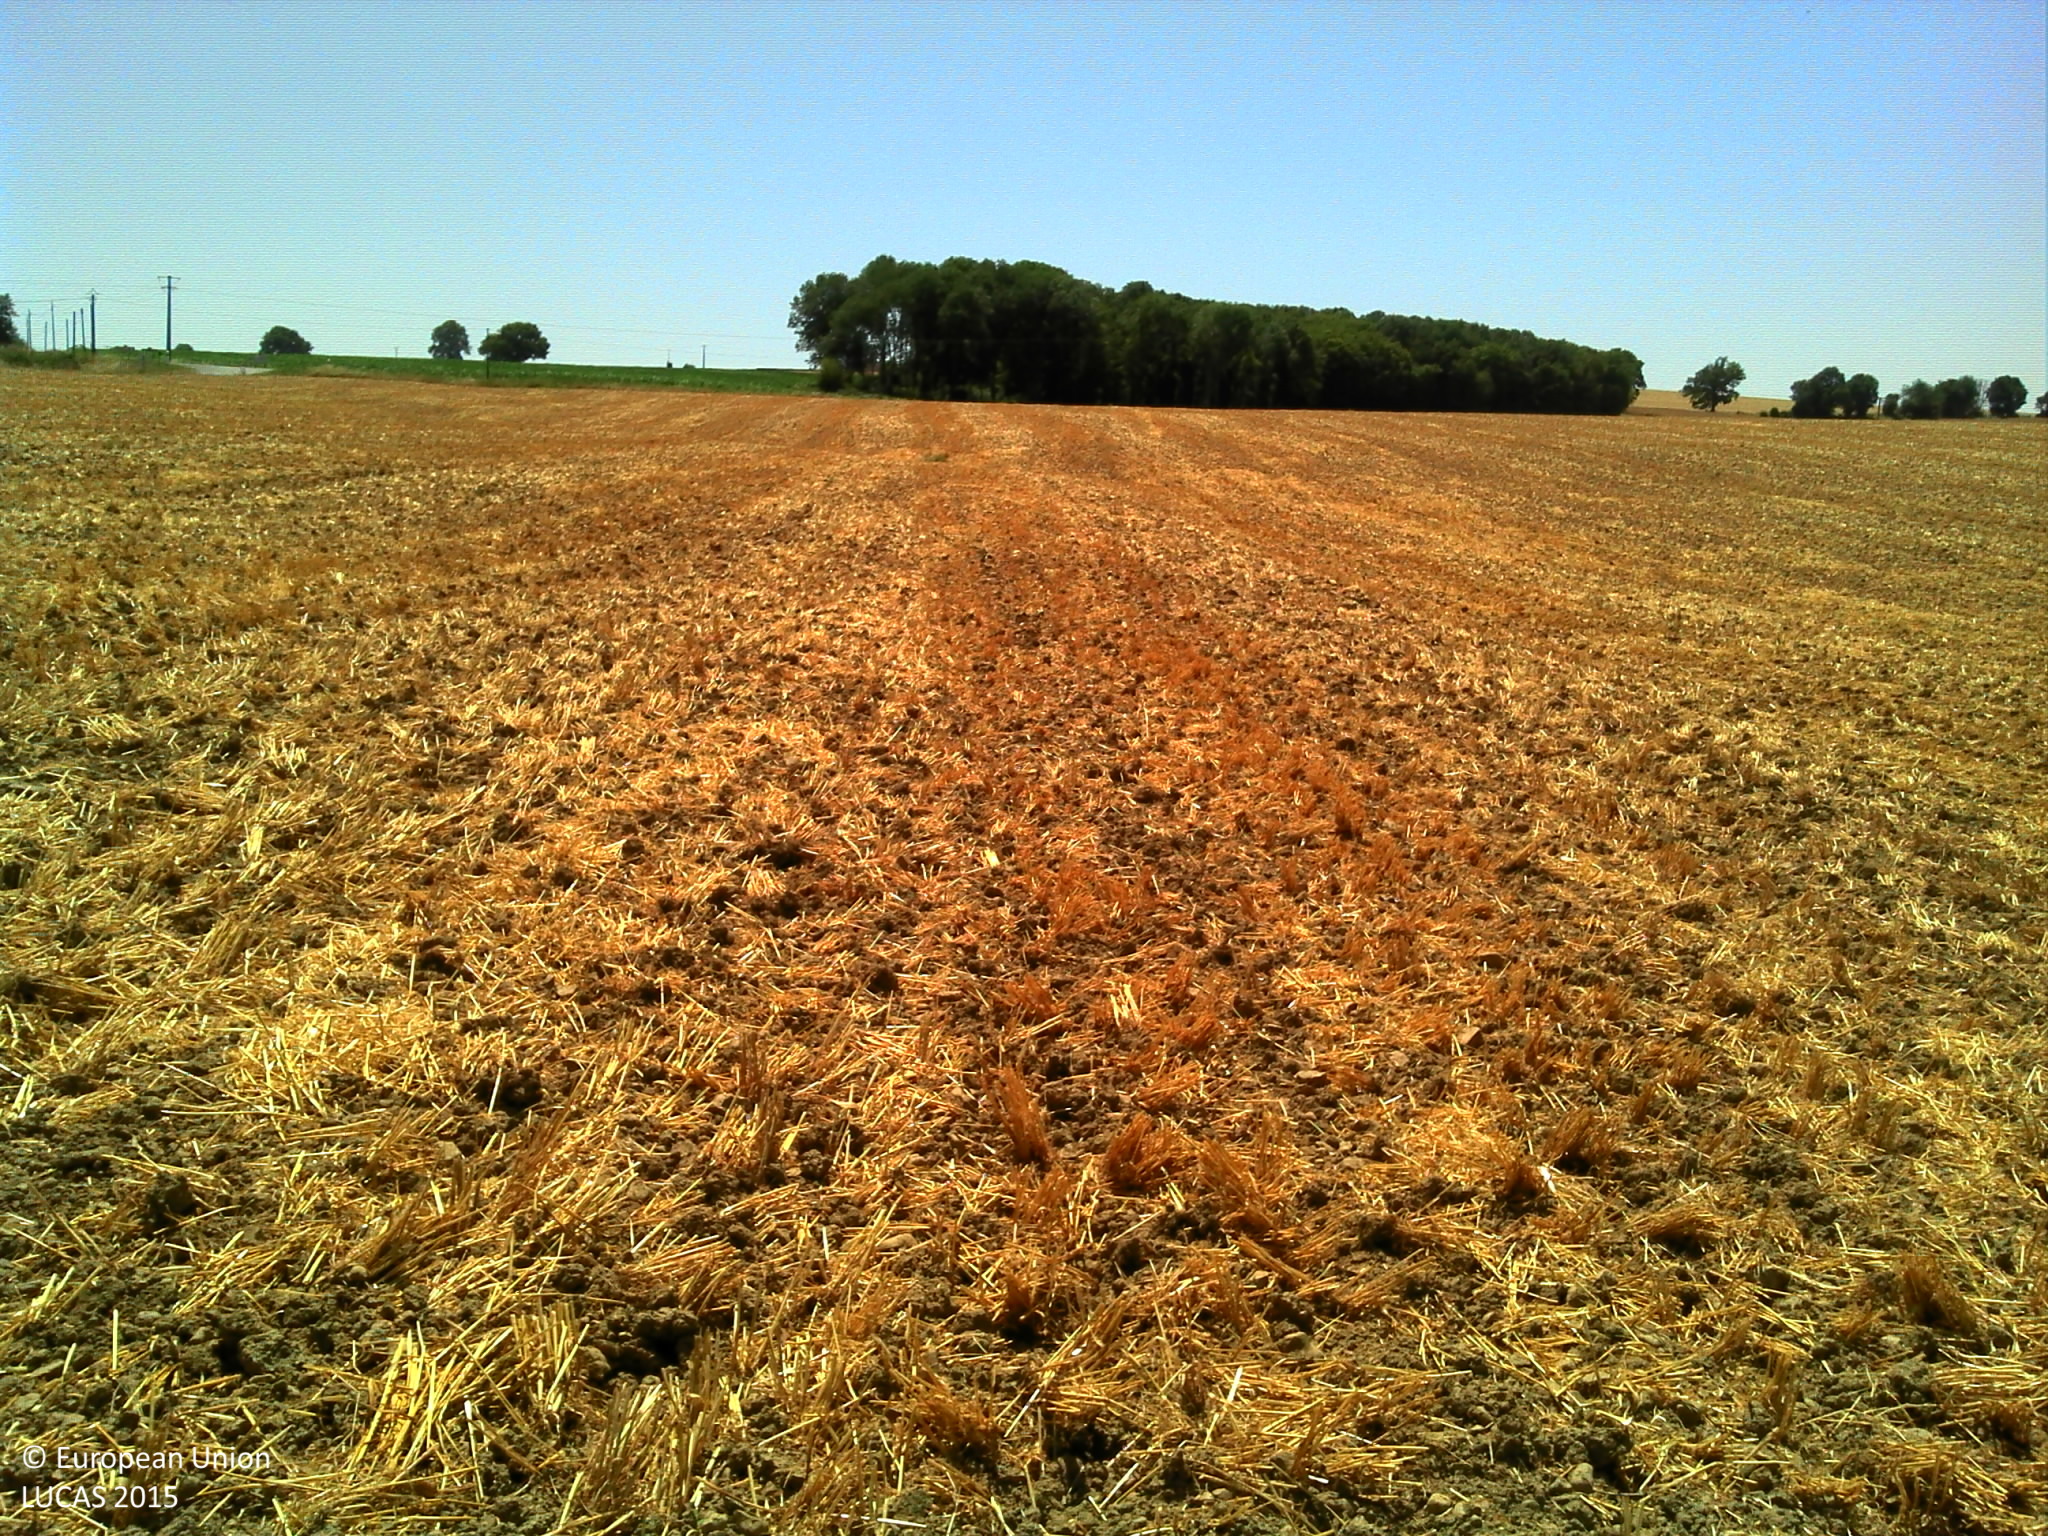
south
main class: Cropland
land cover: Barley
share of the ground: > 75 %
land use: Agriculture (excluding fallow land and kitchen gardens)
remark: Harvested field
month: July
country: FR
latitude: 46.9152
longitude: 3.5508
